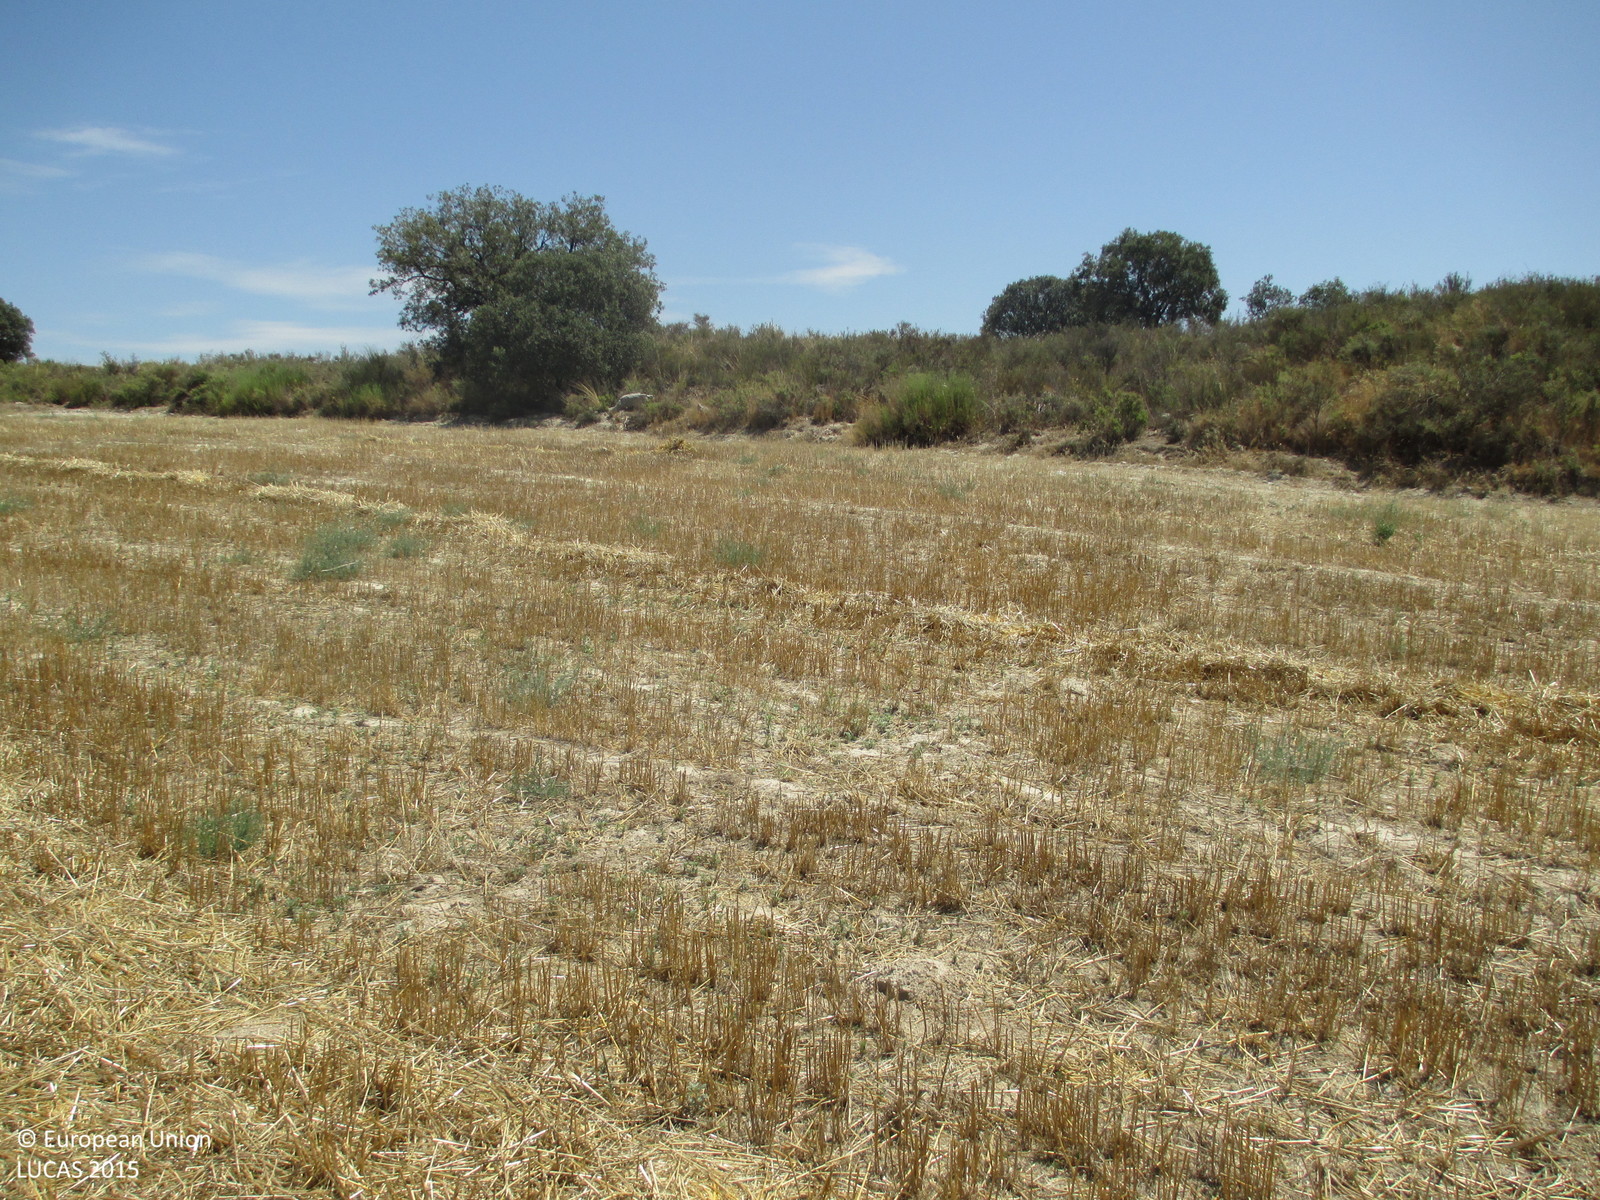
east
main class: Cropland
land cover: Barley
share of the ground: < 10 %
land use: Agriculture (excluding fallow land and kitchen gardens)
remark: Harvested field
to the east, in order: Barley; Shrubland with sparse tree cover; Barley; Grass margins; Tracks; Single bushes/trees; Dry stone walls; Shruby margins; Barley
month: July
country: ES
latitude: 41.9484
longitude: 0.2725
